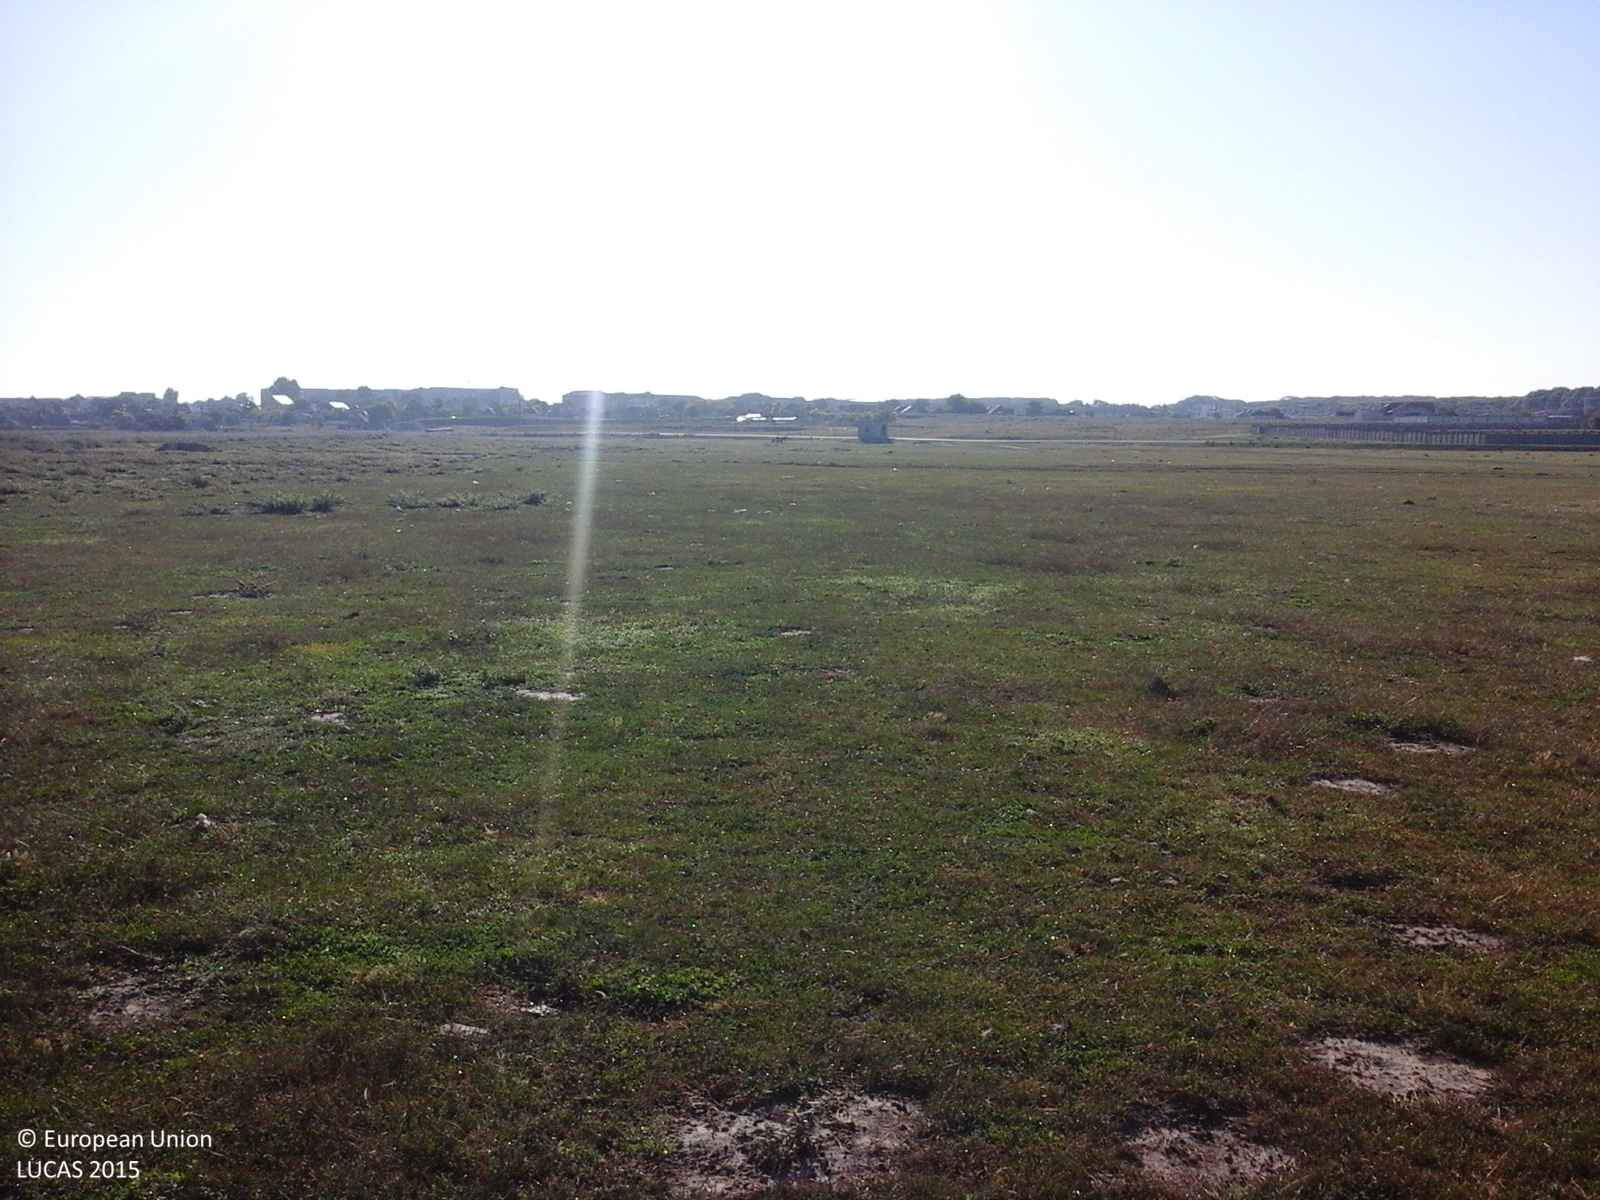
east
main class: Grassland
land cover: Grassland without tree/shrub cover
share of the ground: > 75 %
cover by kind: herbaceous plants 100 %
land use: Agriculture (excluding fallow land and kitchen gardens)
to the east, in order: Grassland without tree/shrub cover; Tracks; Grassland without tree/shrub cover
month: August
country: RO
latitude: 44.3585
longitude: 28.4509
